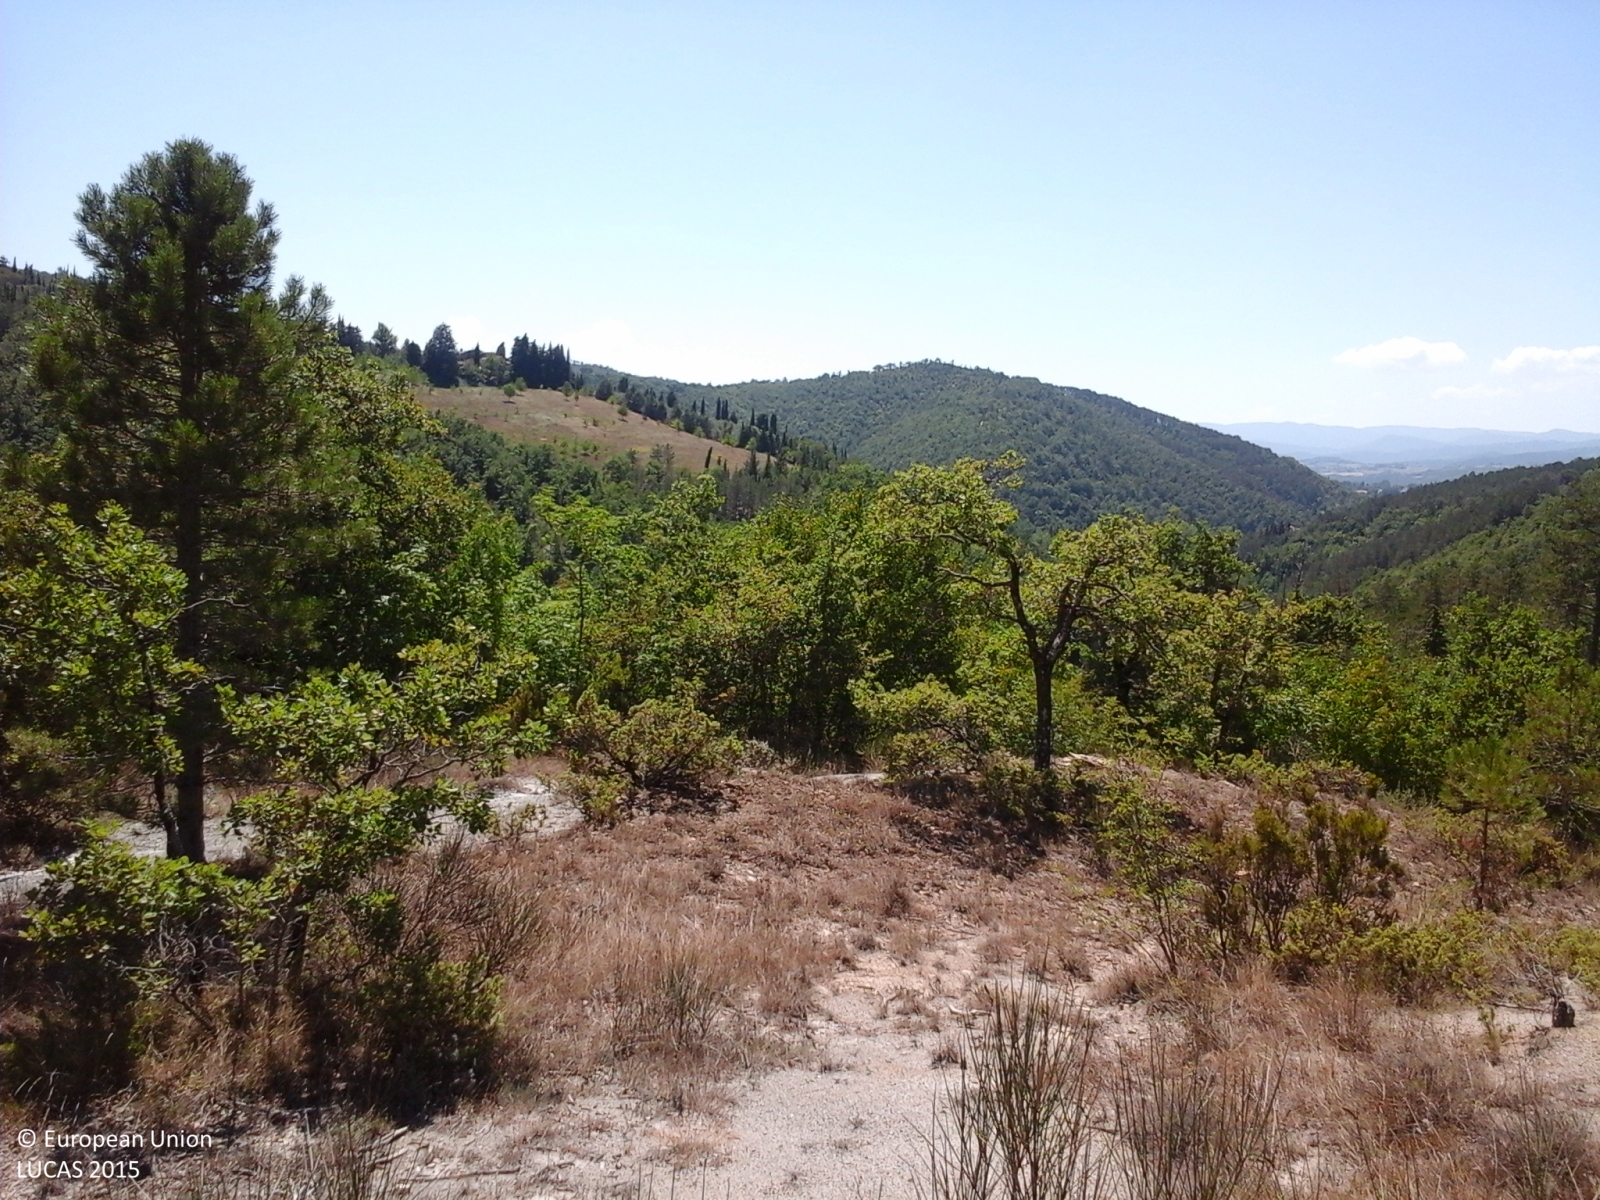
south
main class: Shrubland
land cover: Shrubland with sparse tree cover
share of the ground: > 75 %
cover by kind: shrubs 95 %, broadleaved forest trees 5 %
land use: Forestry
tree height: > 5 m
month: August
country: IT
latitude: 43.4772
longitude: 12.2810
